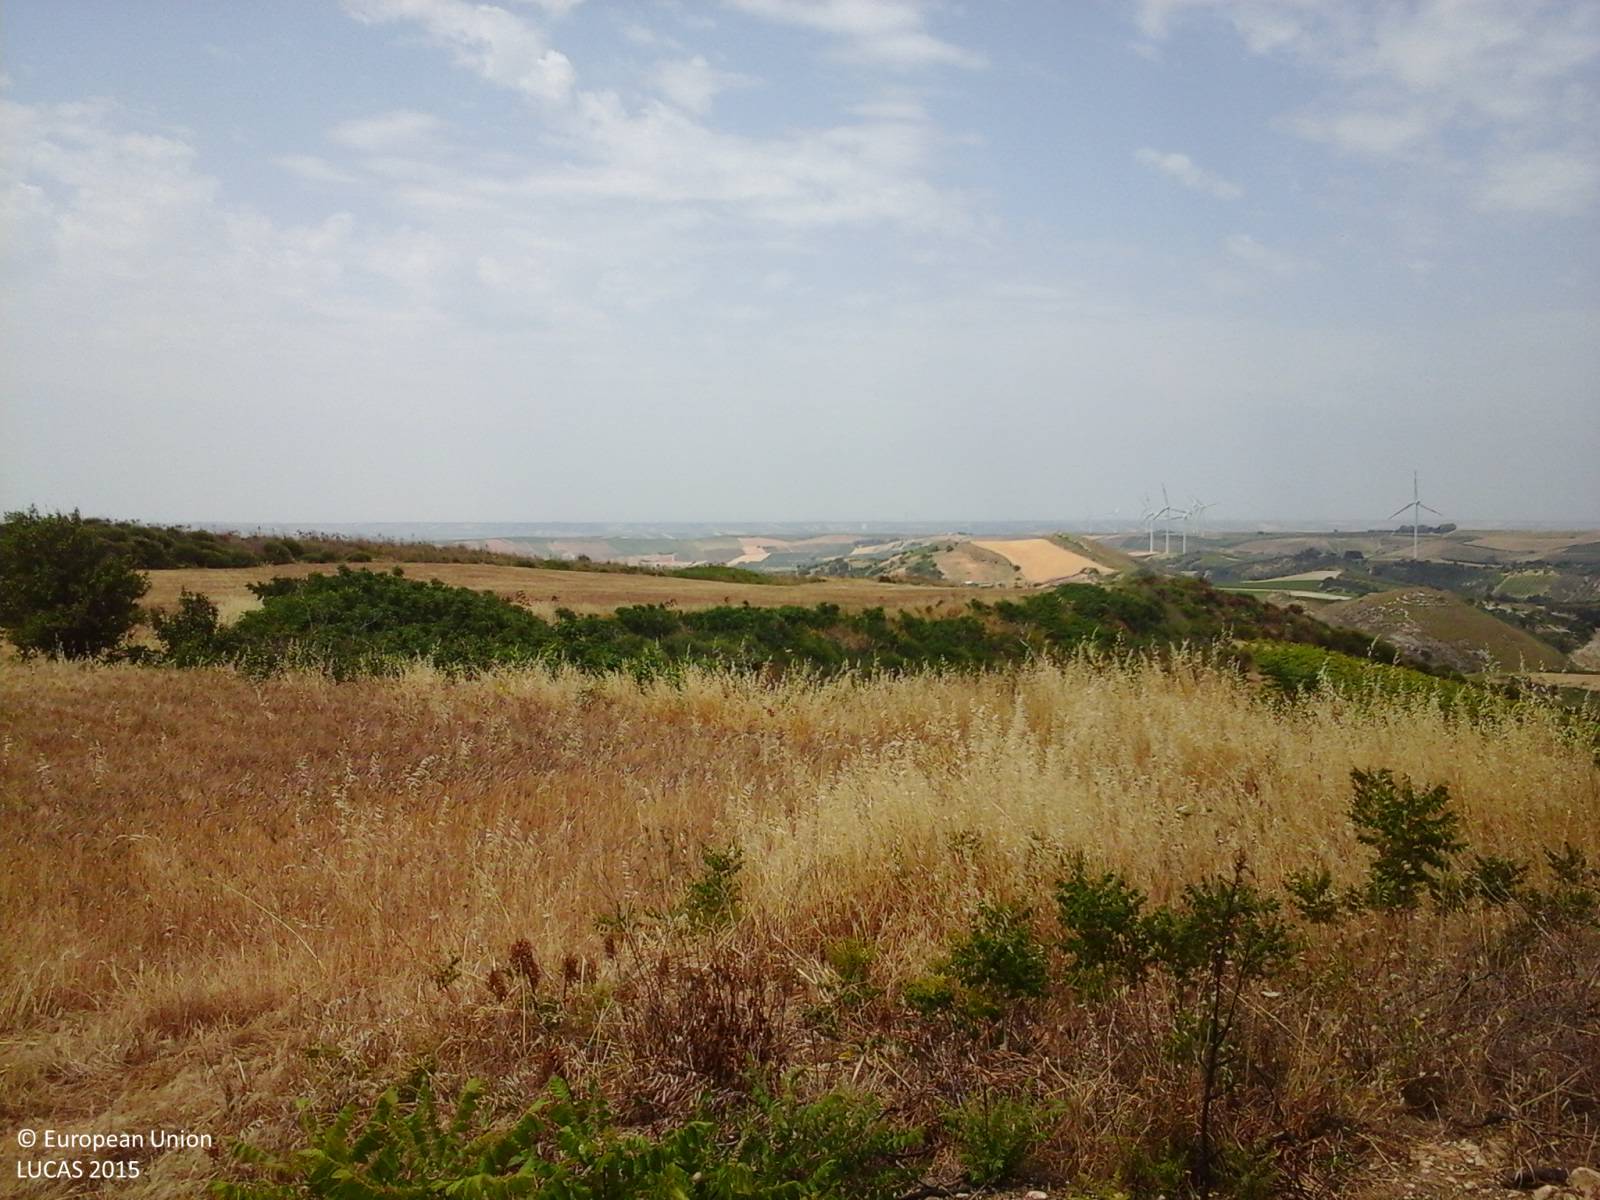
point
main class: Cropland
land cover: Durum wheat
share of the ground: > 75 %
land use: Agriculture (excluding fallow land and kitchen gardens)
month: June
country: IT
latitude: 37.8164
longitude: 12.7626
